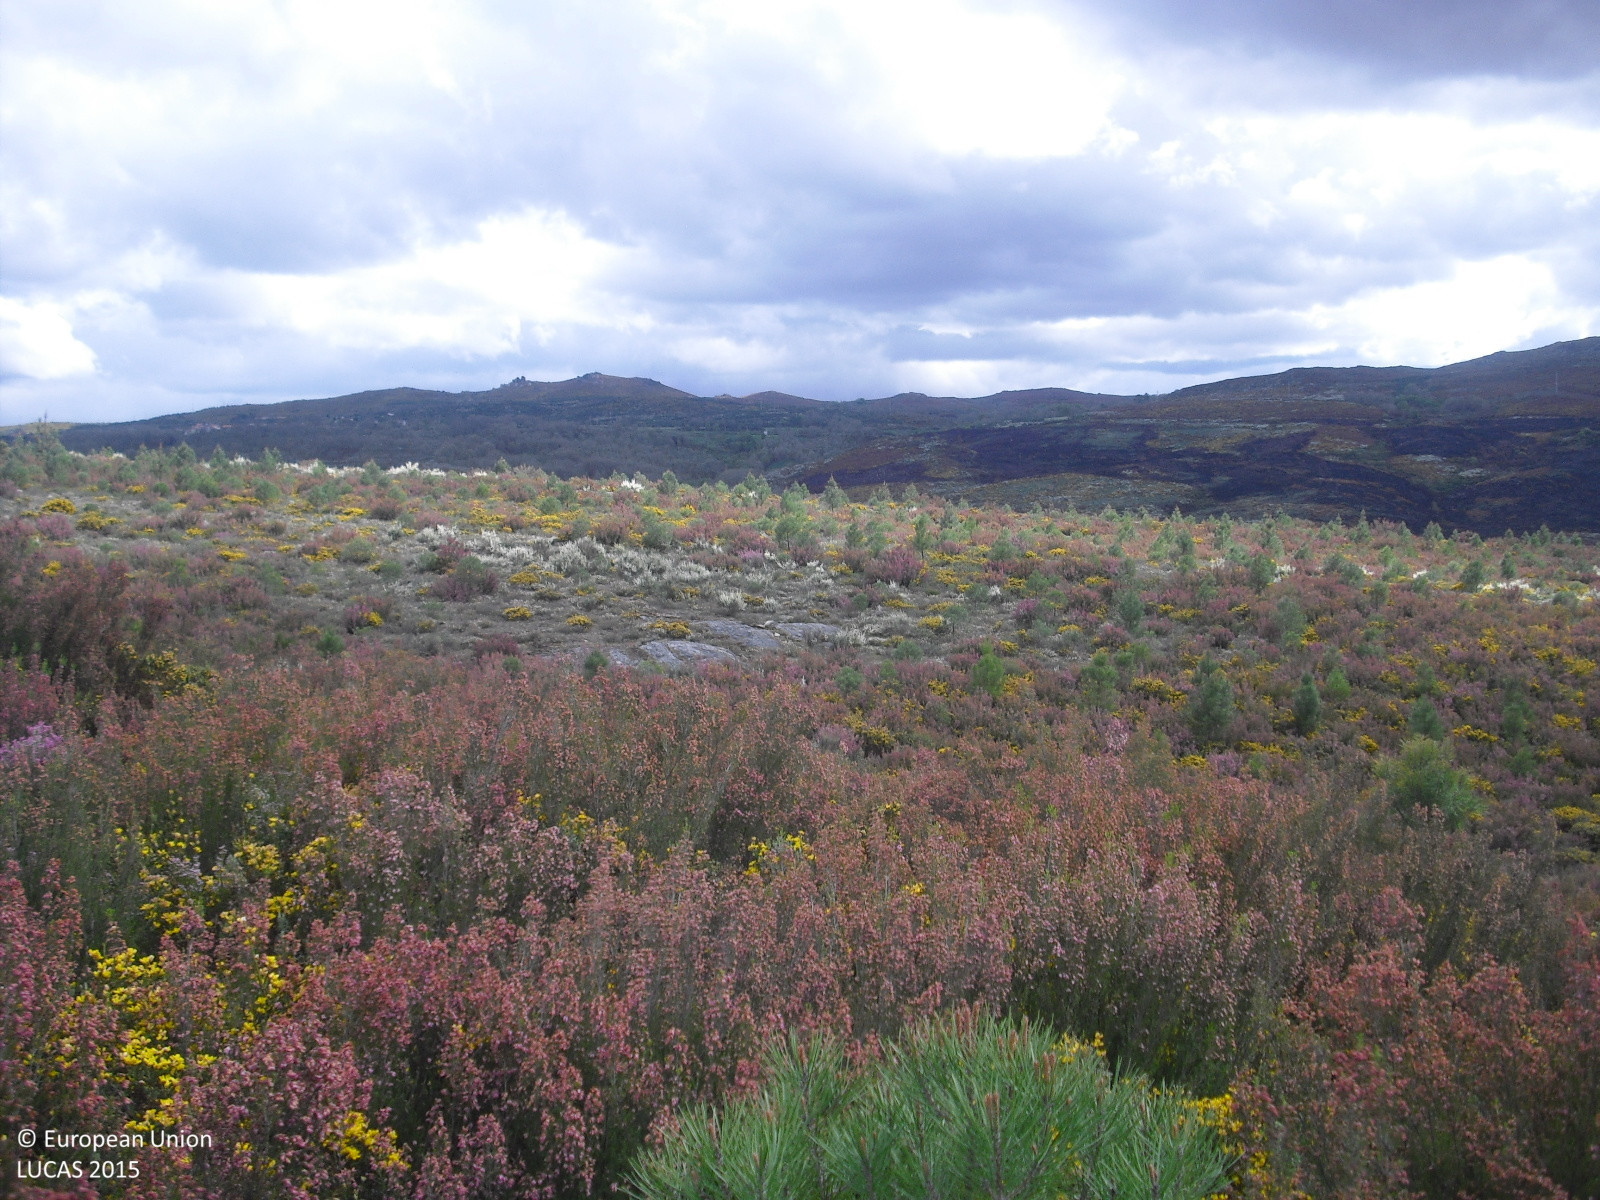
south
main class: Woodland
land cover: Pine dominated coniferous woodland
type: exotic forest
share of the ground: 10 - 25 %
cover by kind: shrubs 50 %, coniferous forest trees 30 %, herbaceous plants 15 %, consolidated bare surface 5 %
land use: Forestry
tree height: < 5 m
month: April
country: ES
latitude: 41.8348
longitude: -7.6078
